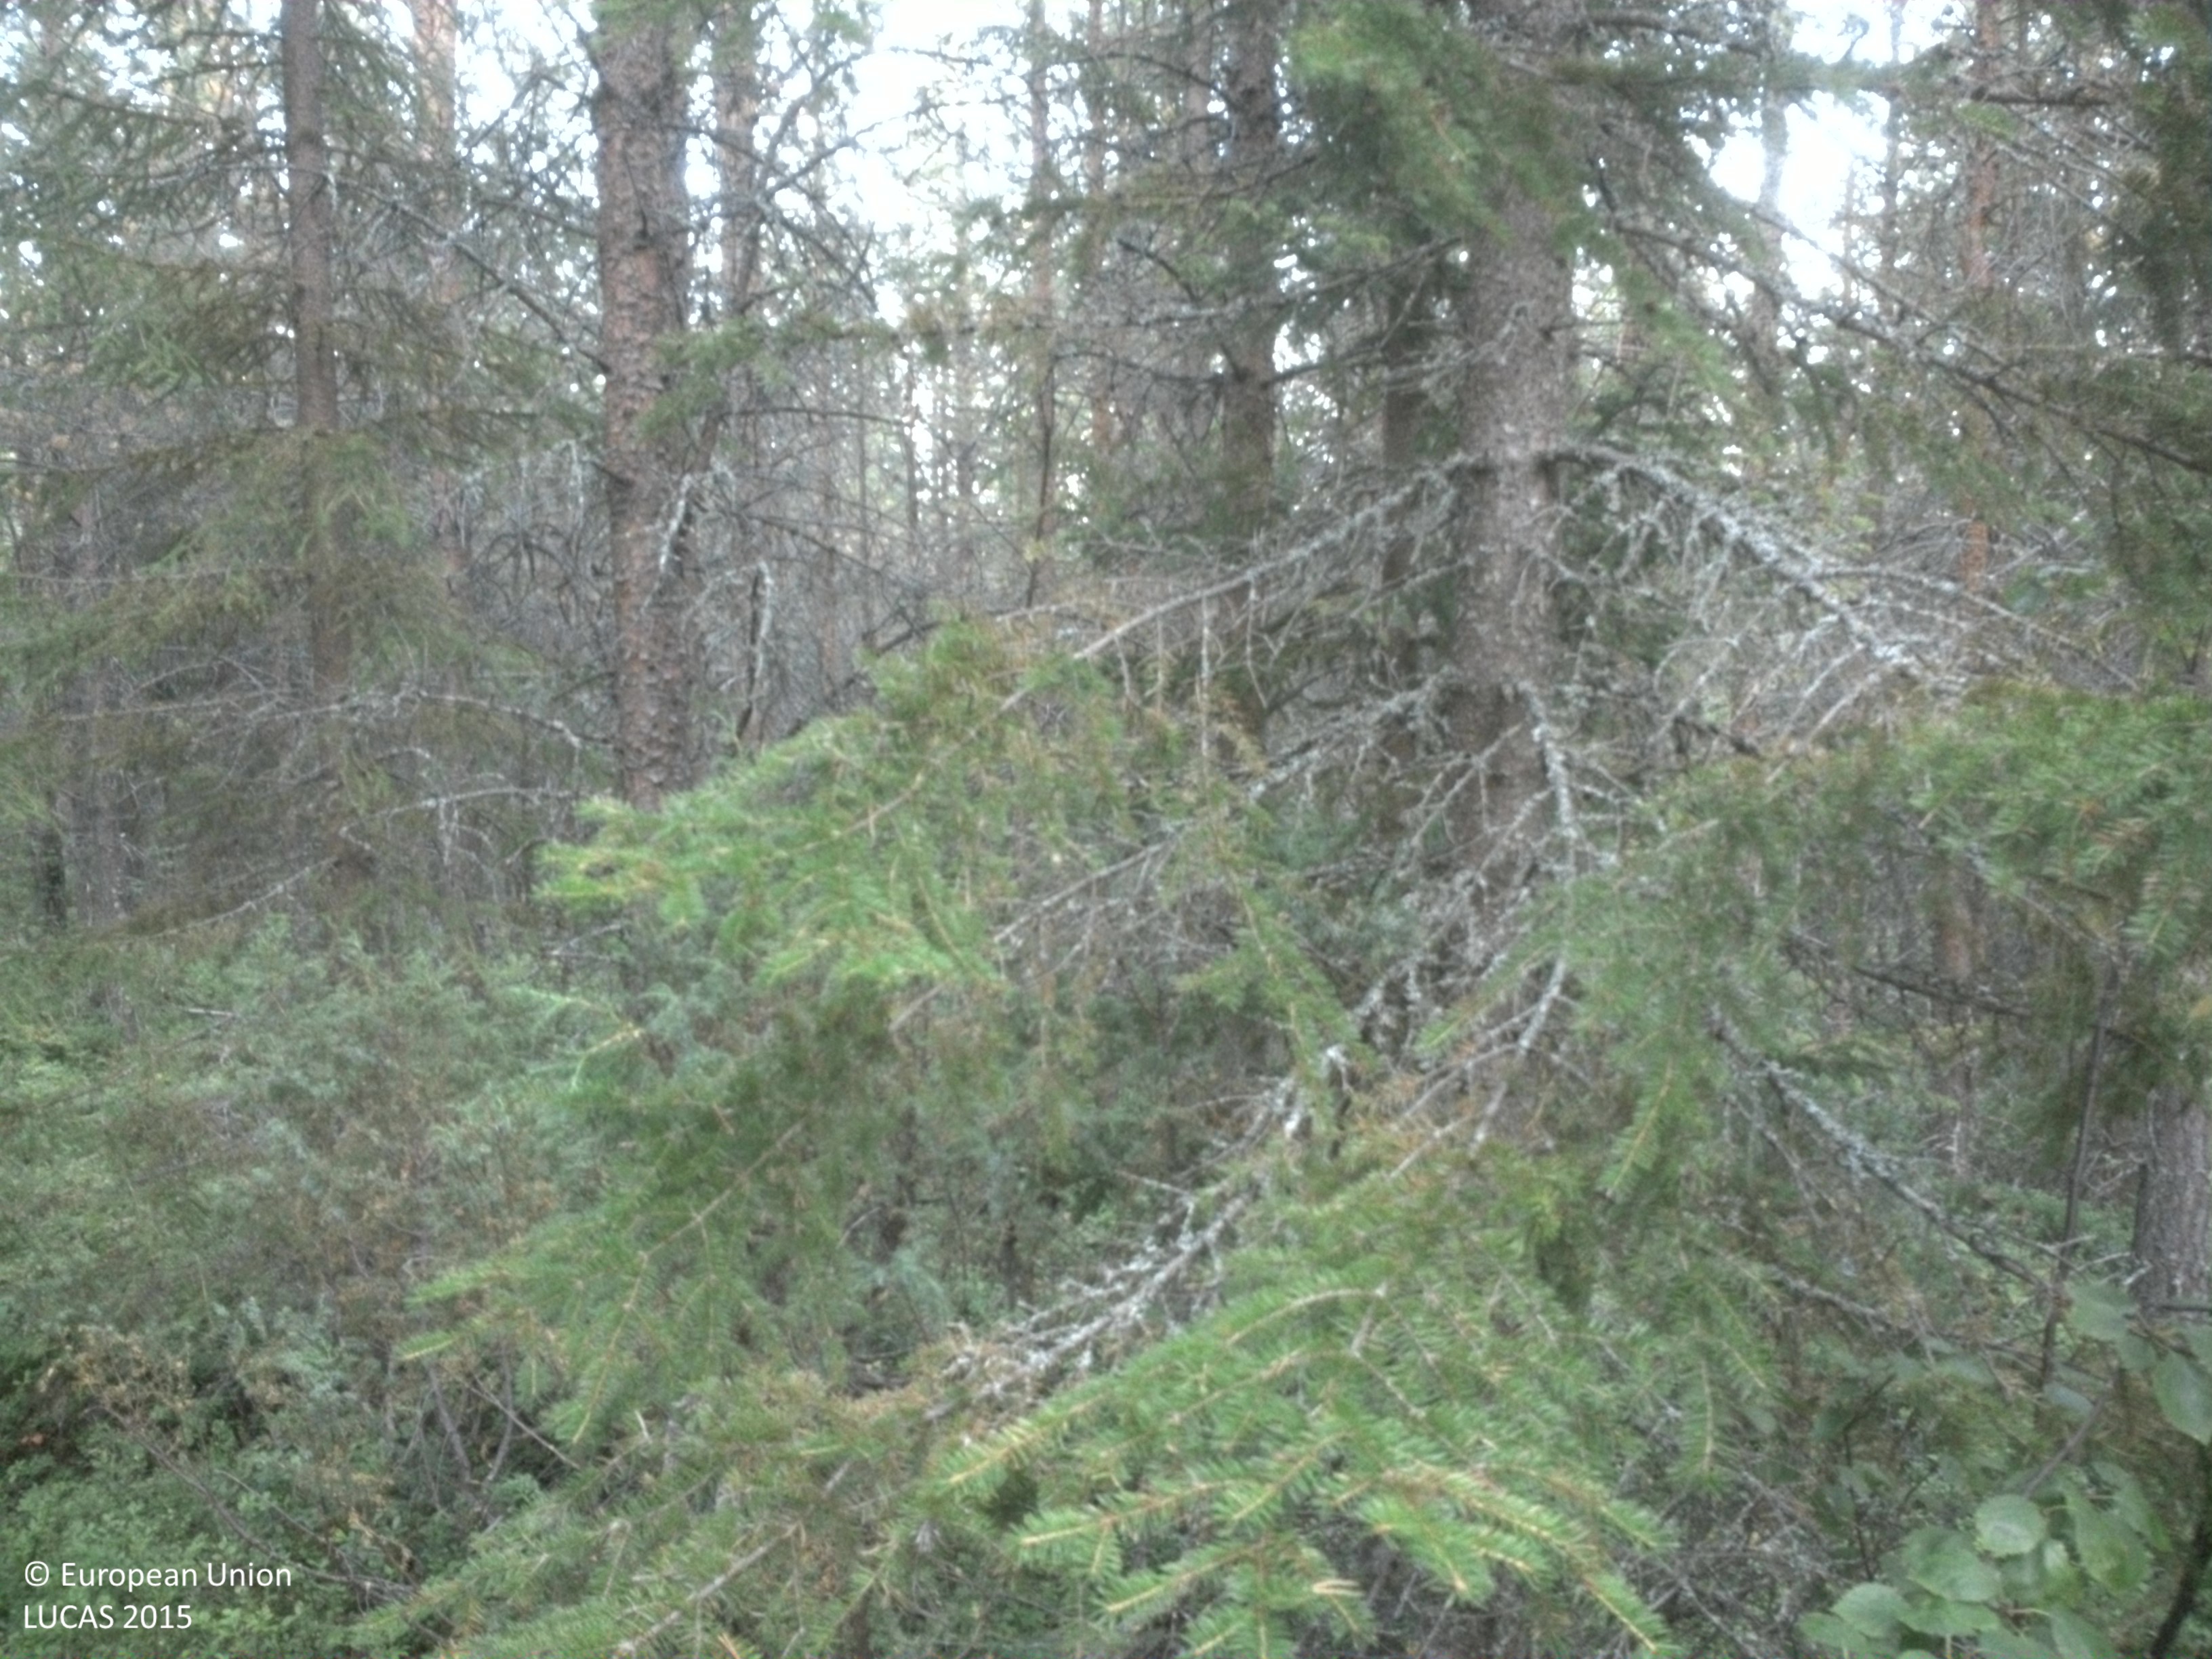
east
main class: Woodland
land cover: Pine dominated coniferous woodland
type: boreal forest
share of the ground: 50 - 75 %
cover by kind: coniferous forest trees 60 %, shrubs 30 %, broadleaved forest trees 5 %, lichens and mosses 5 %
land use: Forestry
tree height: > 5 m
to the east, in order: Pine dominated coniferous woodland; Spruce dominated mixed woodland; Pine dominated coniferous woodland
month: August
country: SE
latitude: 64.6122
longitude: 18.3916
